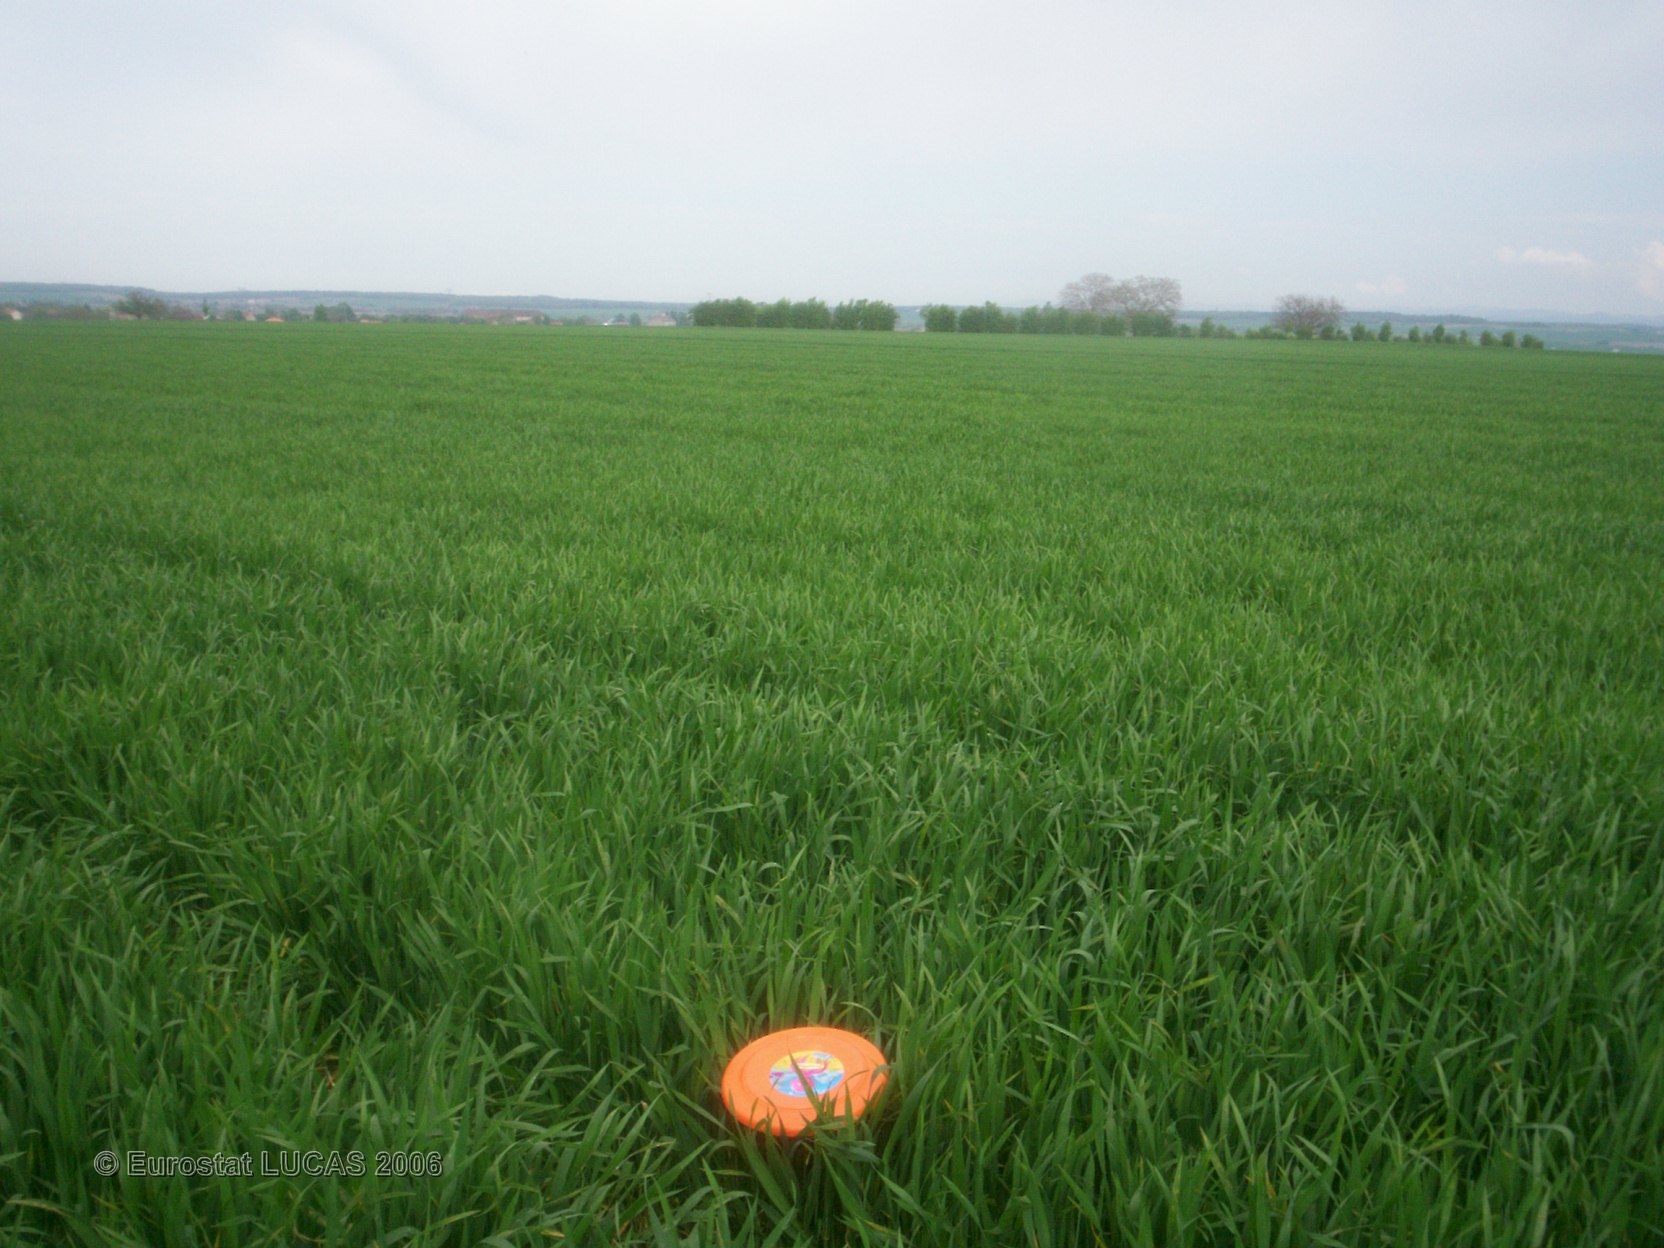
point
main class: Cropland
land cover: Common wheat
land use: Agriculture (excluding fallow land and kitchen gardens)
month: May
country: FR
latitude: 46.0290
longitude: 3.2427
